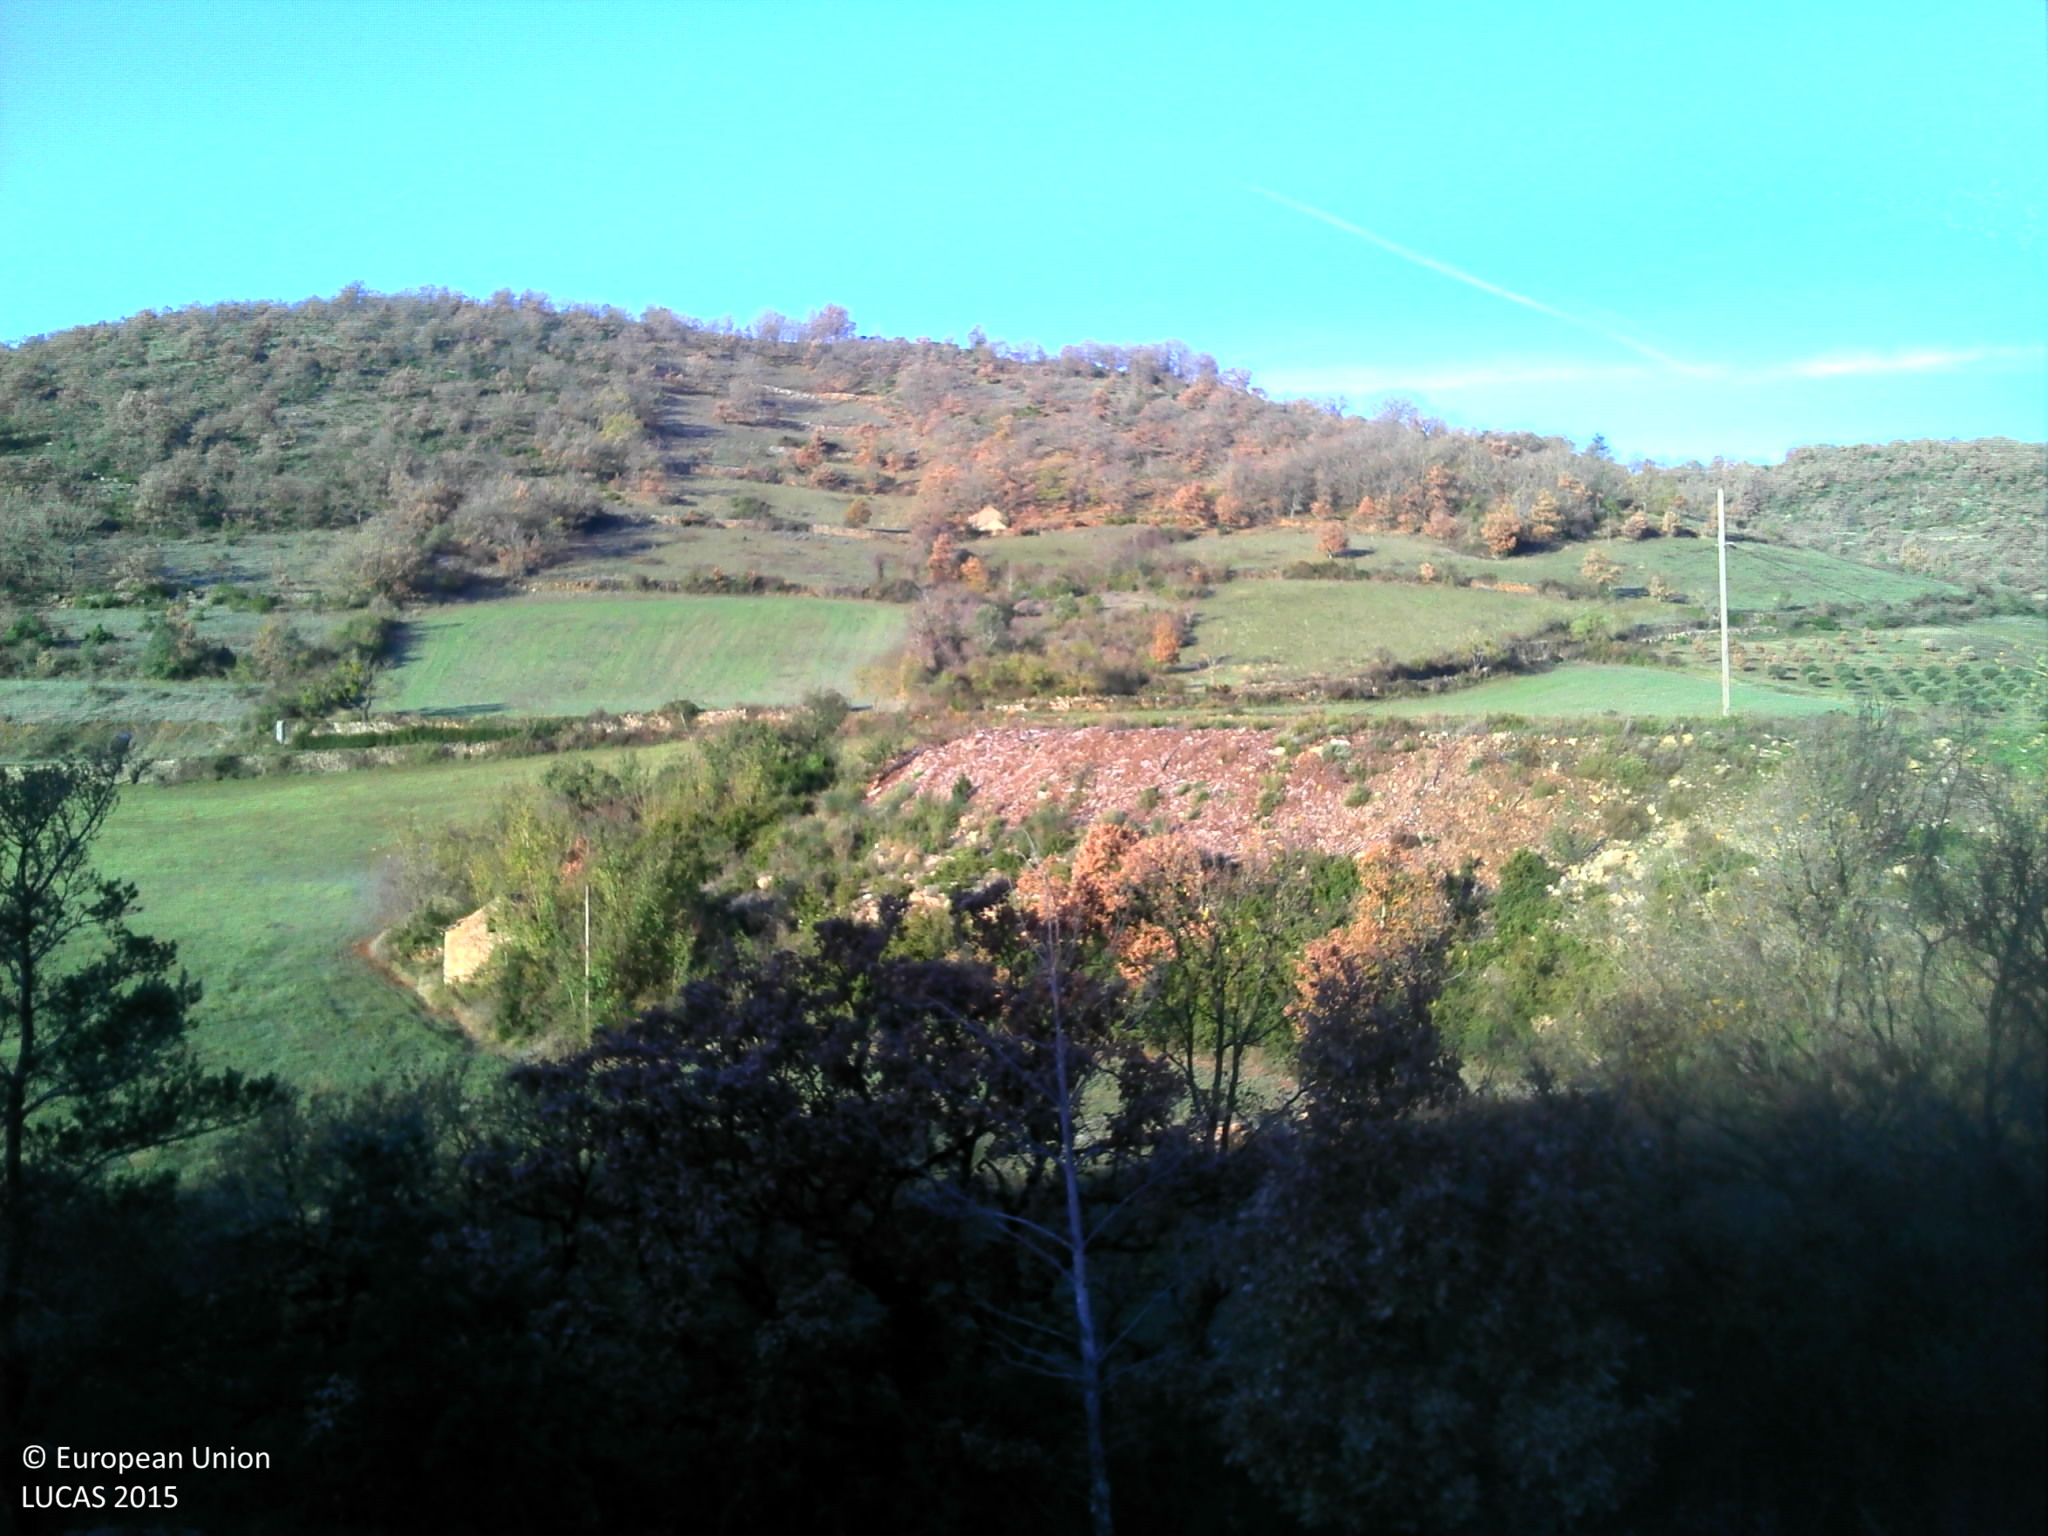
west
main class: Grassland
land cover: Grassland without tree/shrub cover
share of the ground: > 75 %
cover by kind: herbaceous plants 100 %
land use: Agriculture (excluding fallow land and kitchen gardens)
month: November
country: FR
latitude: 44.0958
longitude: 2.9983
